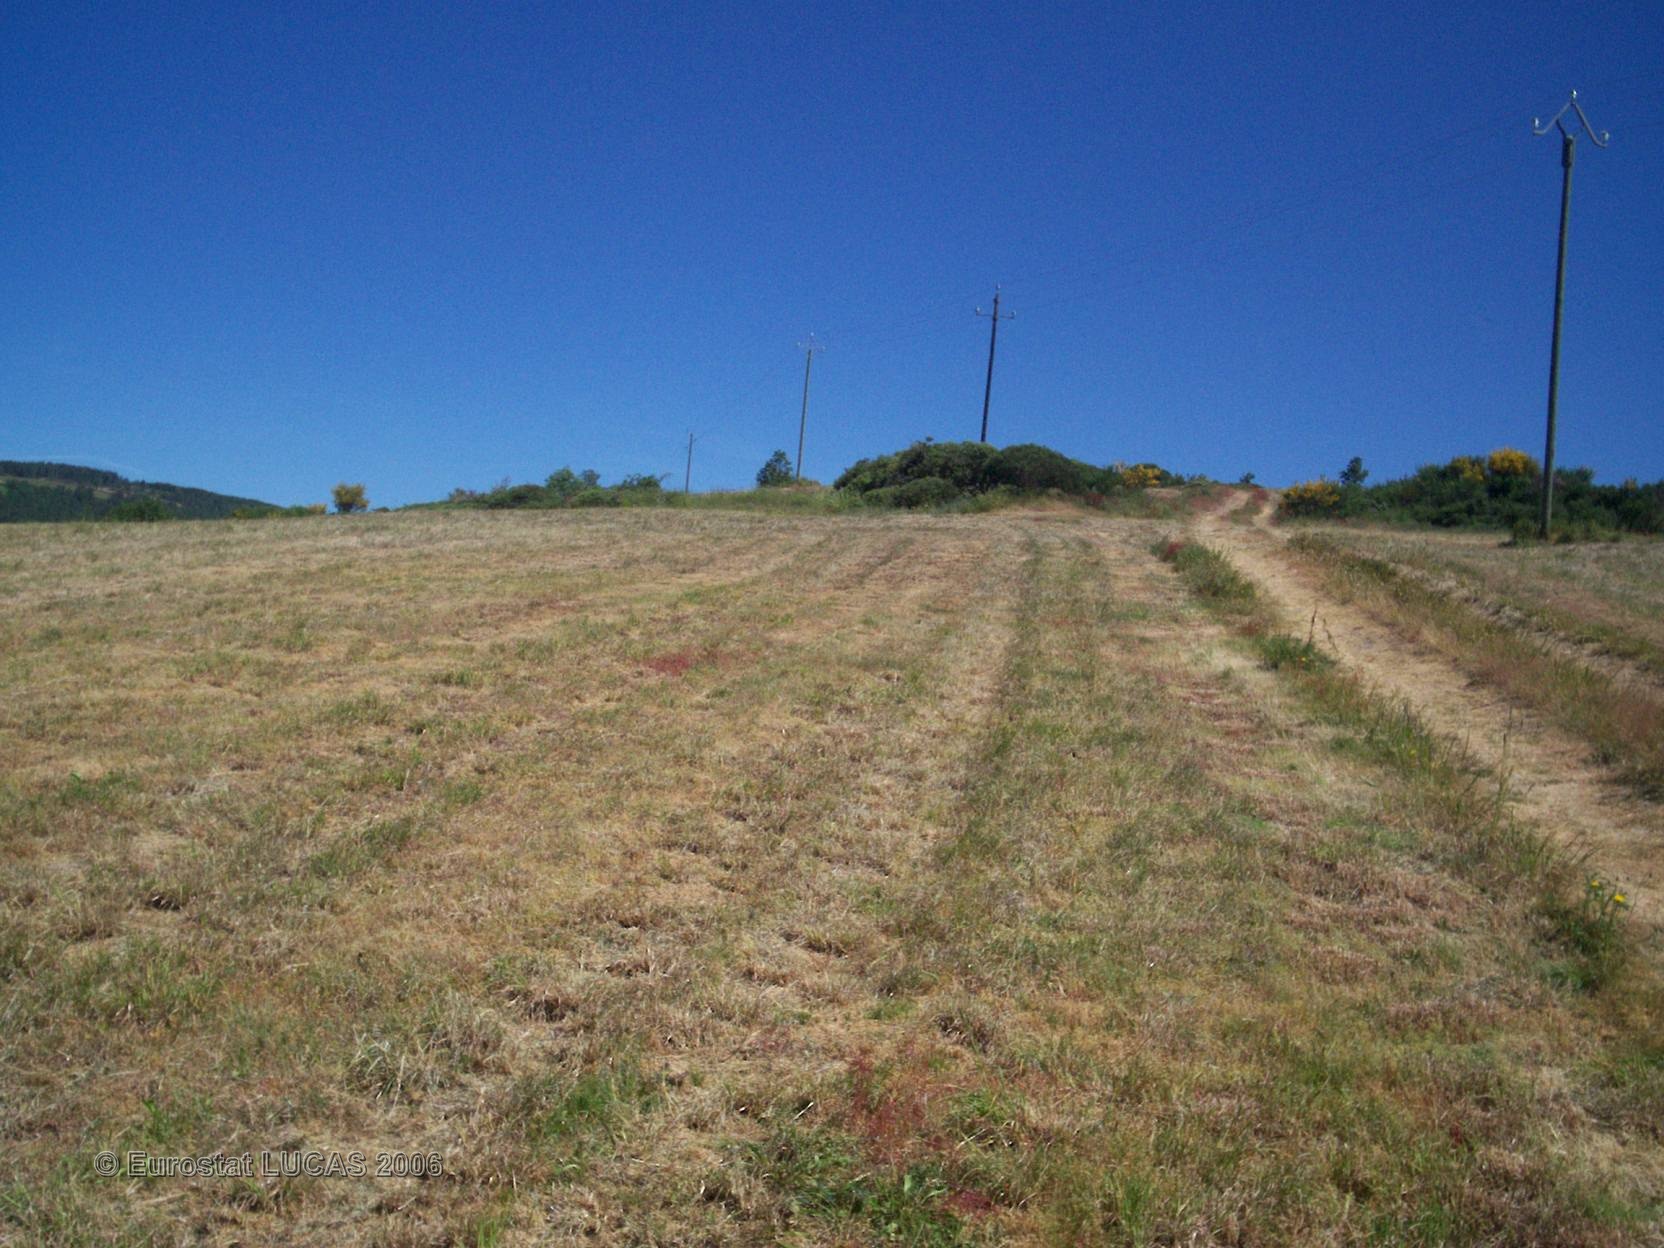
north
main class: Grassland
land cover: Grassland without tree/shrub cover
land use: Agriculture (excluding fallow land and kitchen gardens)
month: June
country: FR
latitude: 44.5398
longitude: 3.4227
